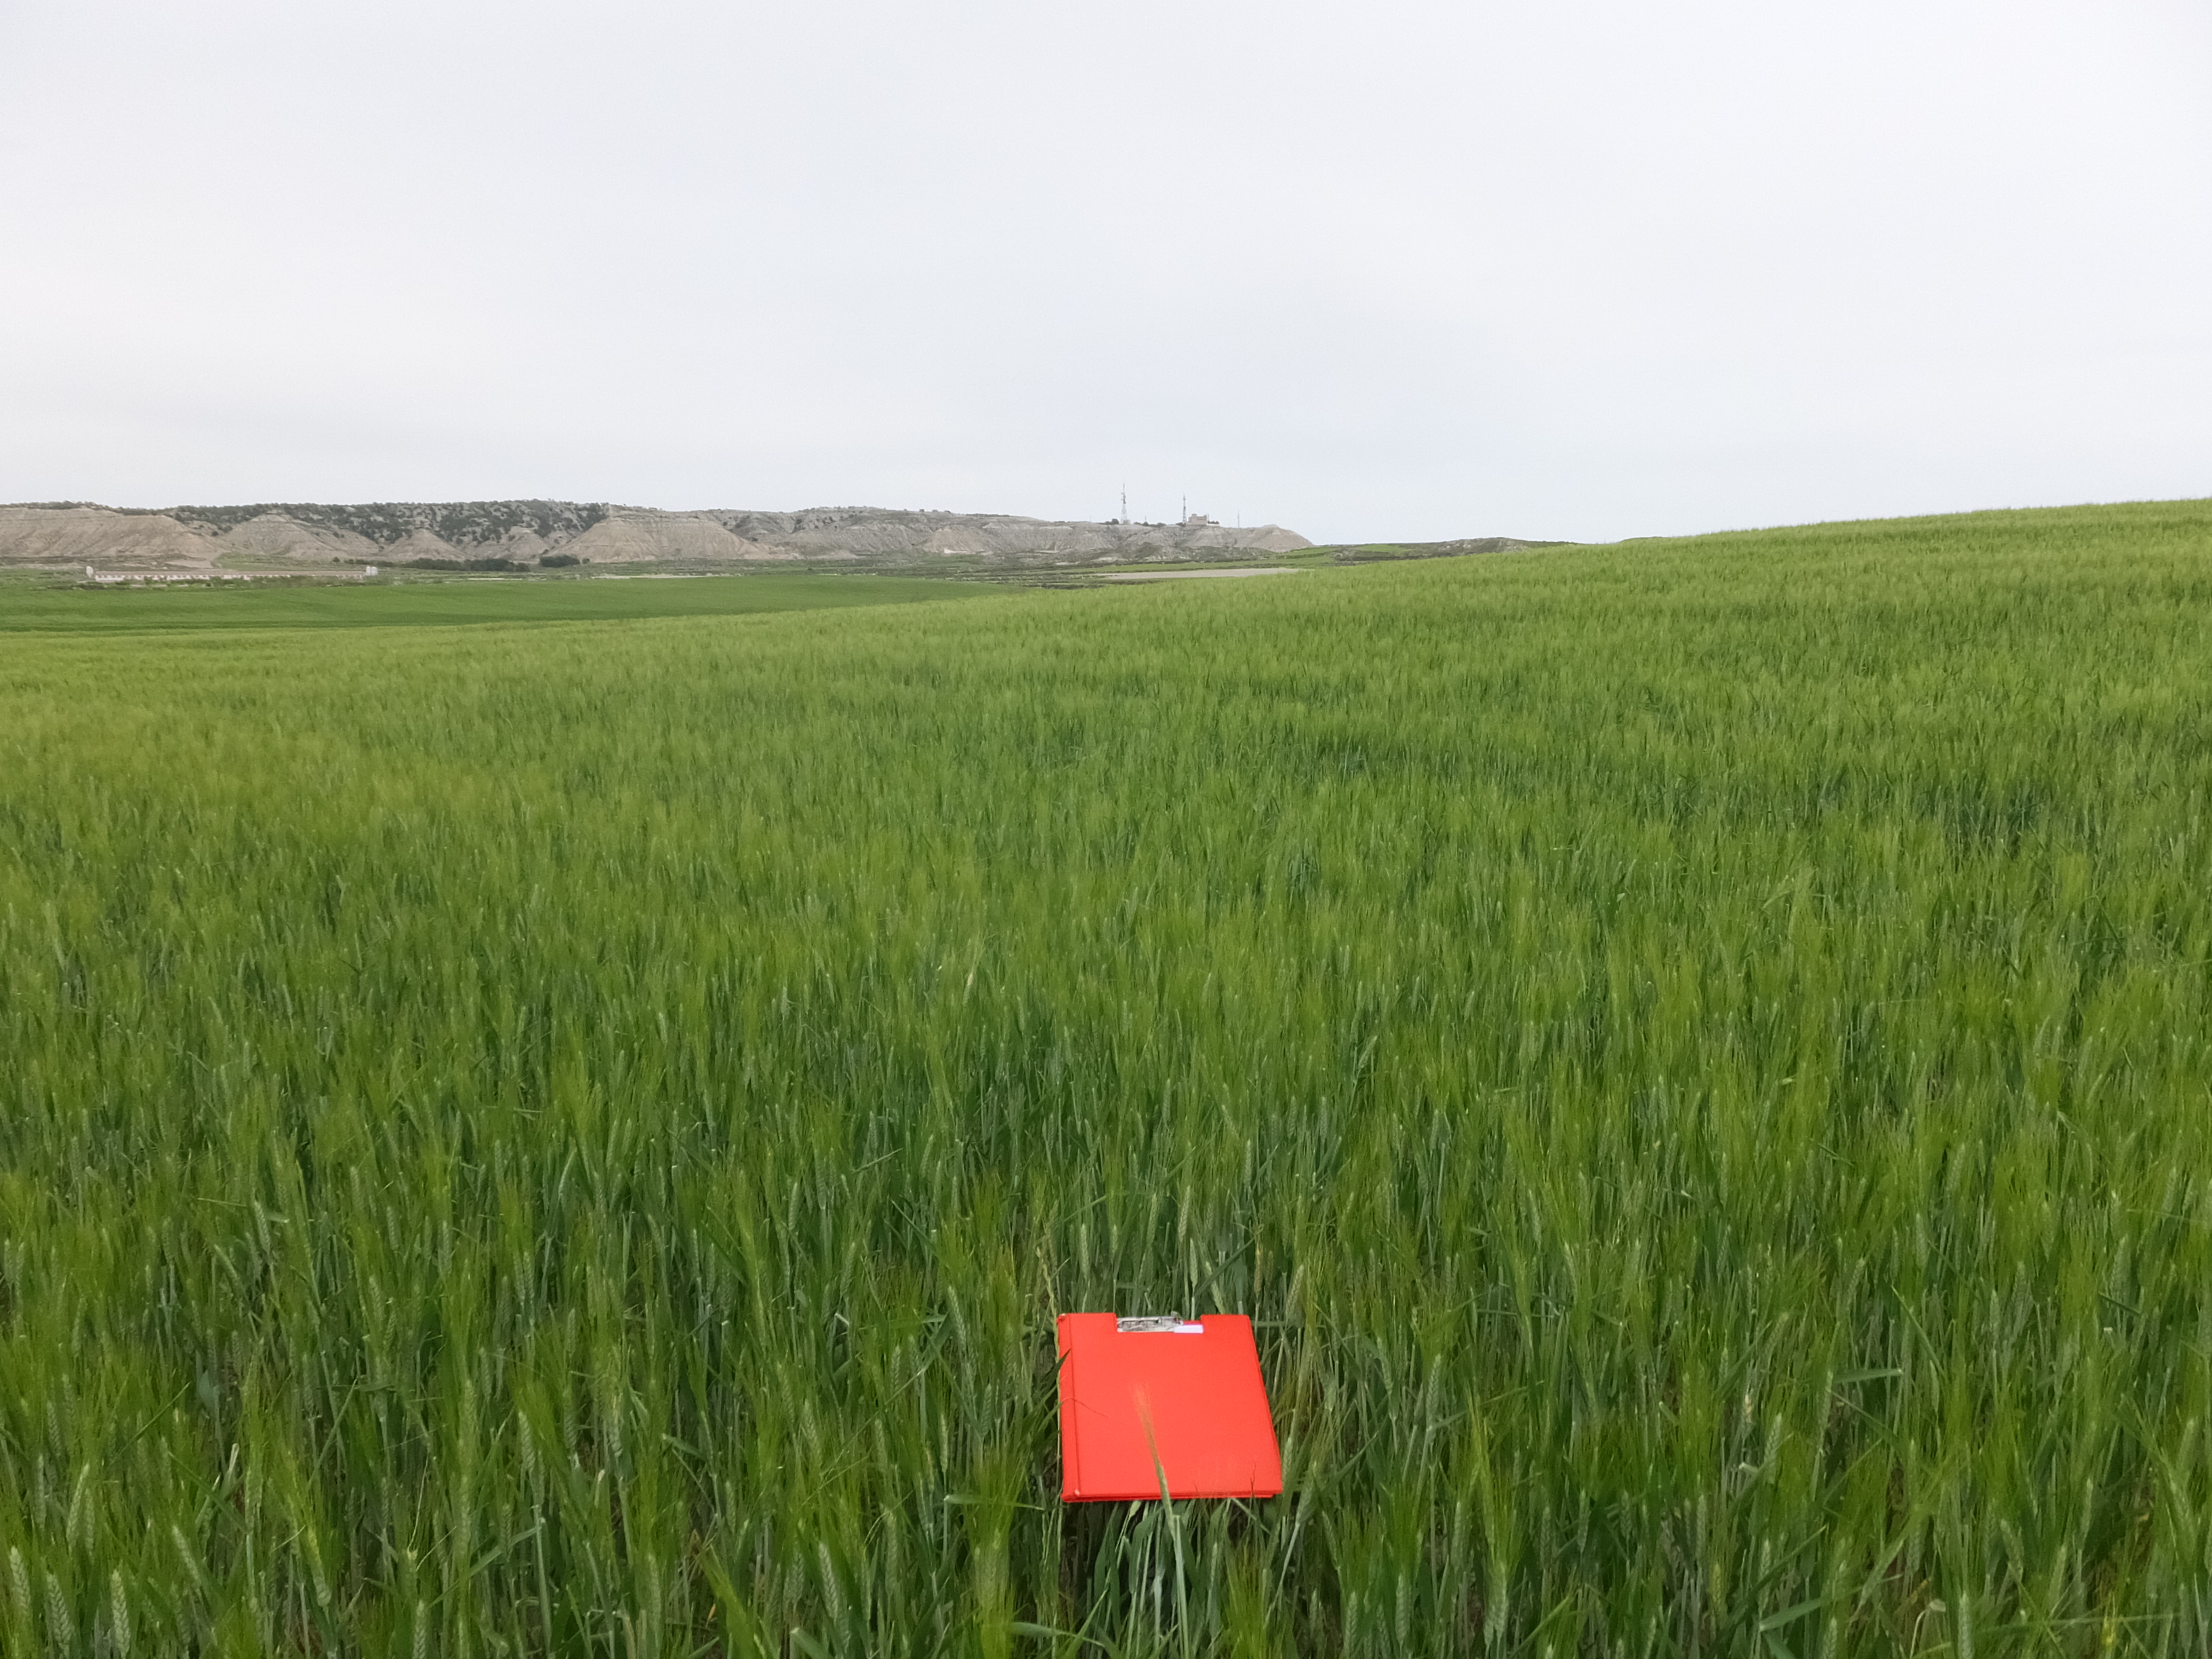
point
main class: Cropland
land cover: Durum wheat
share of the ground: > 75 %
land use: Agriculture (excluding fallow land and kitchen gardens)
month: April
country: ES
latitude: 41.5511
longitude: -0.2430
